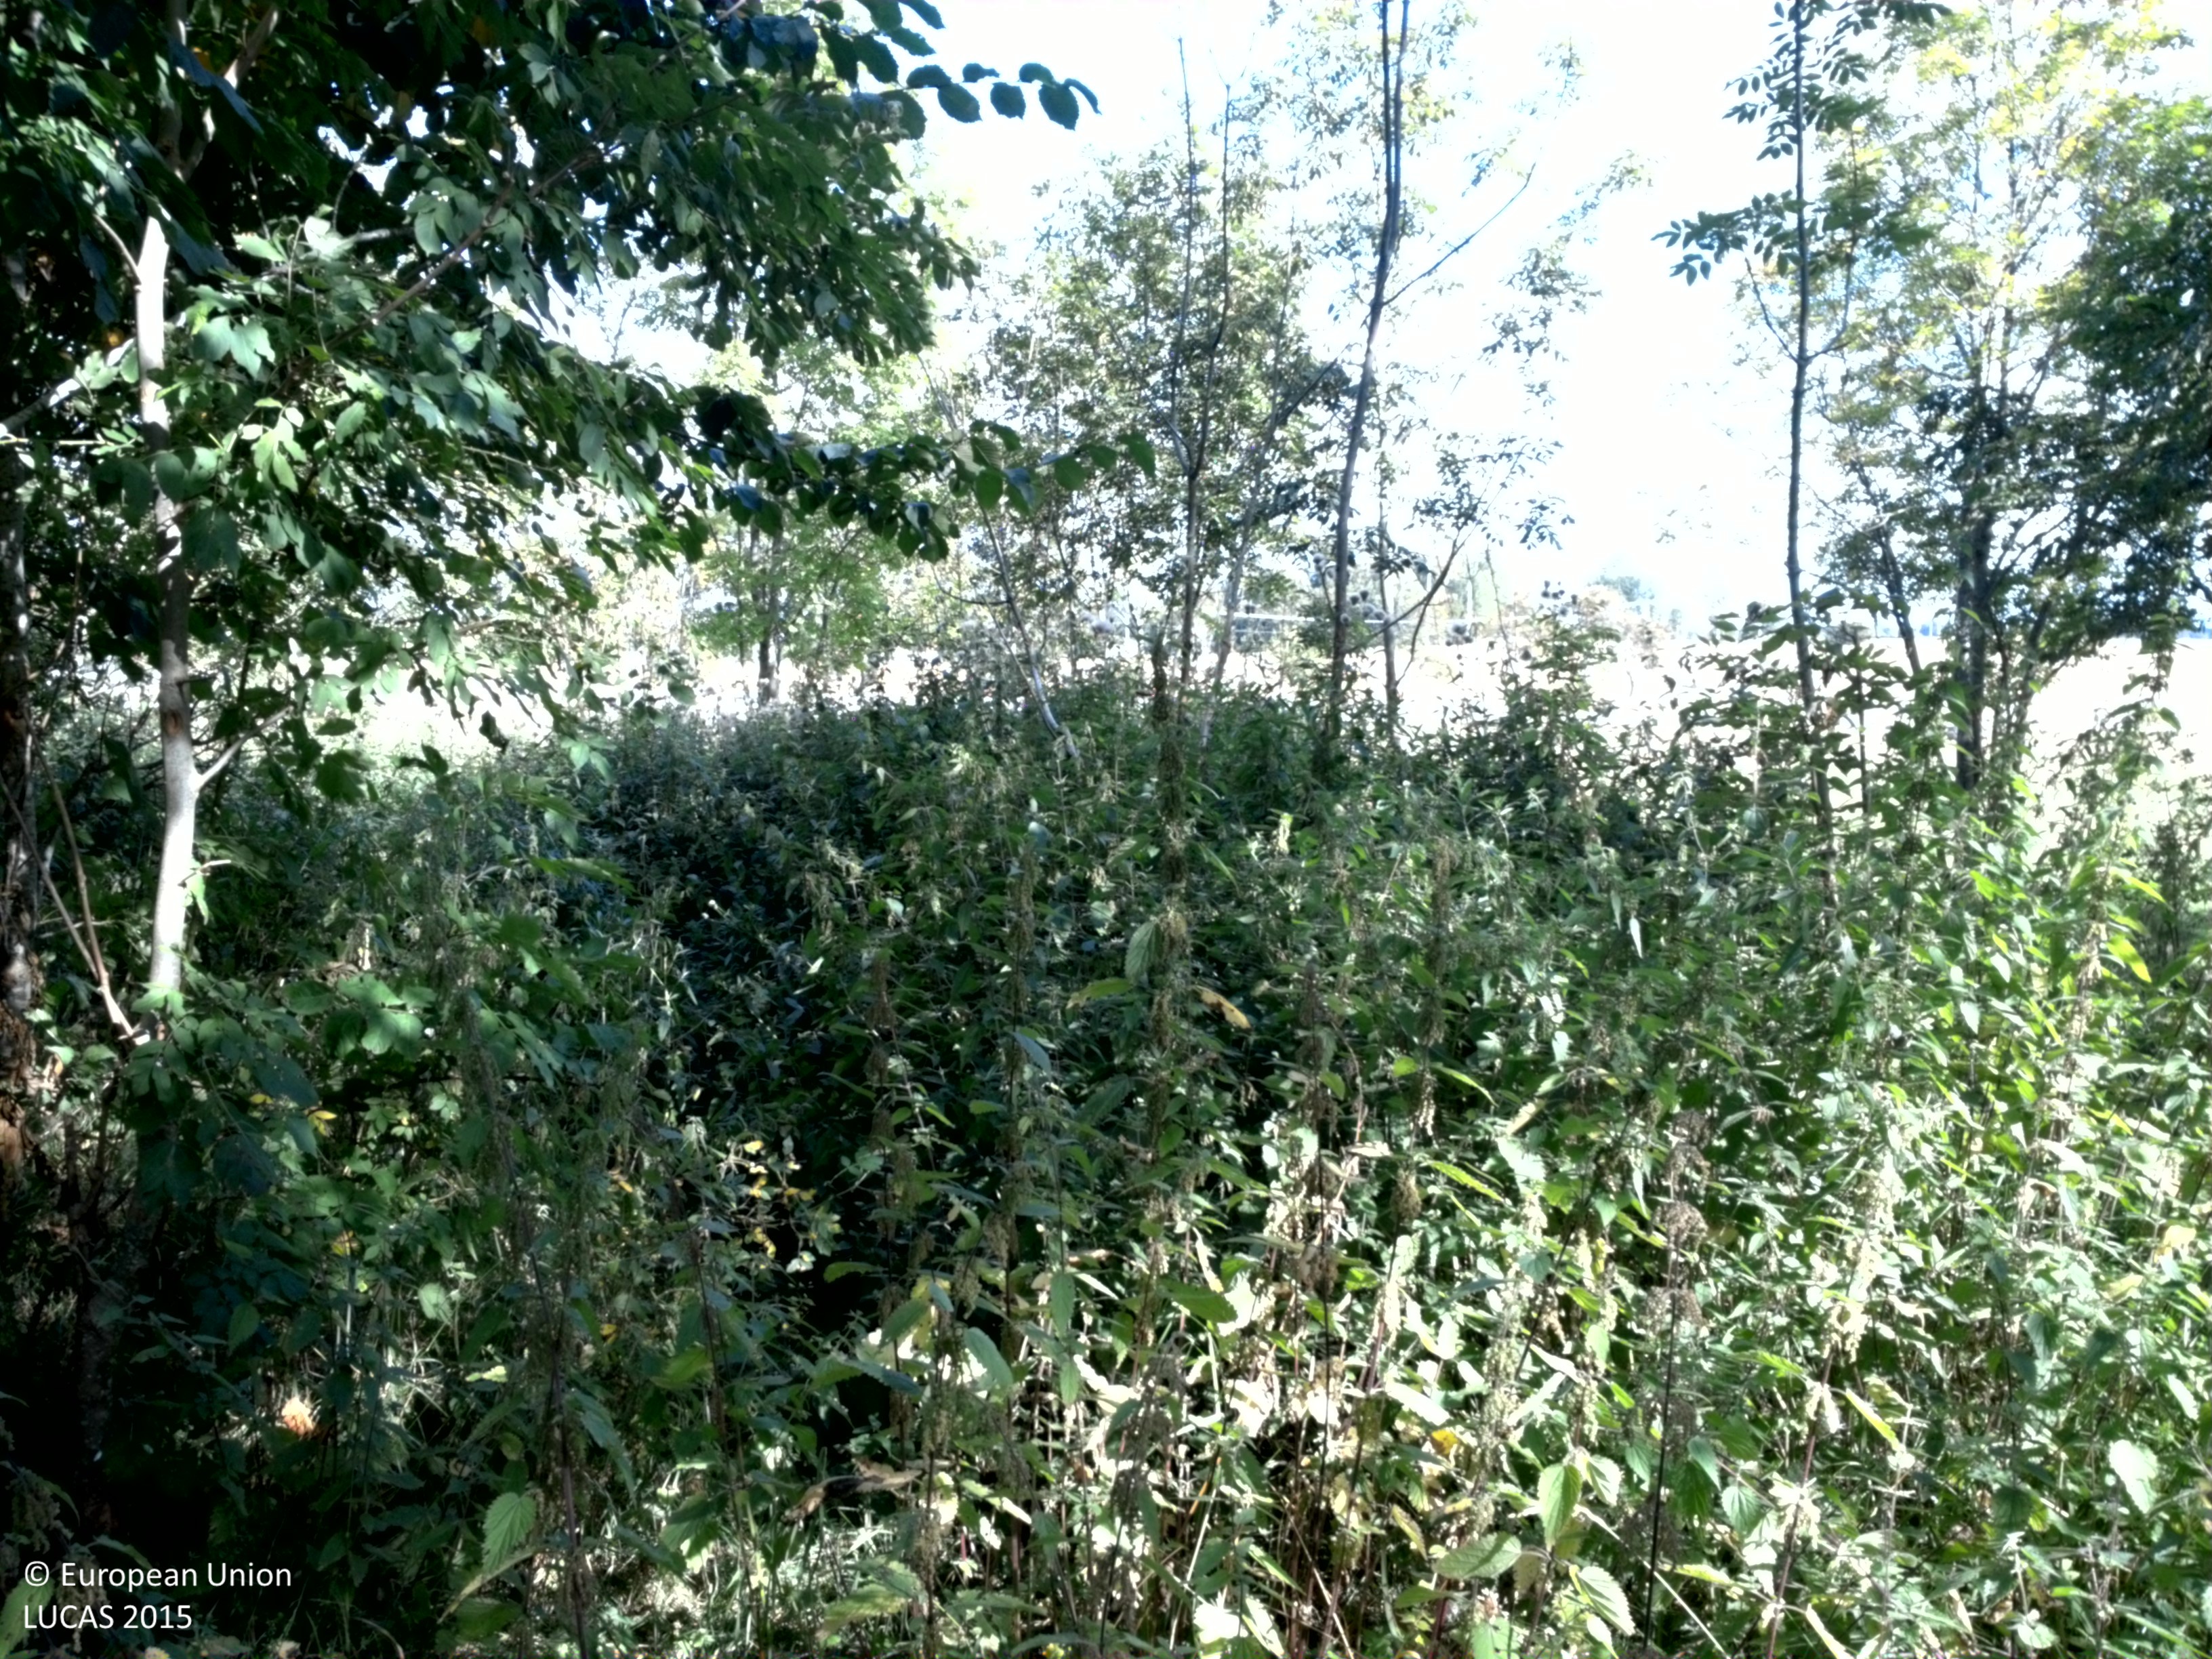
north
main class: Woodland
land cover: Broadleaved woodland
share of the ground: > 75 %
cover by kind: broadleaved forest trees 75 %, herbaceous plants 25 %
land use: Agriculture (excluding fallow land and kitchen gardens)
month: August
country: SE
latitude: 59.5940
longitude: 17.6301
